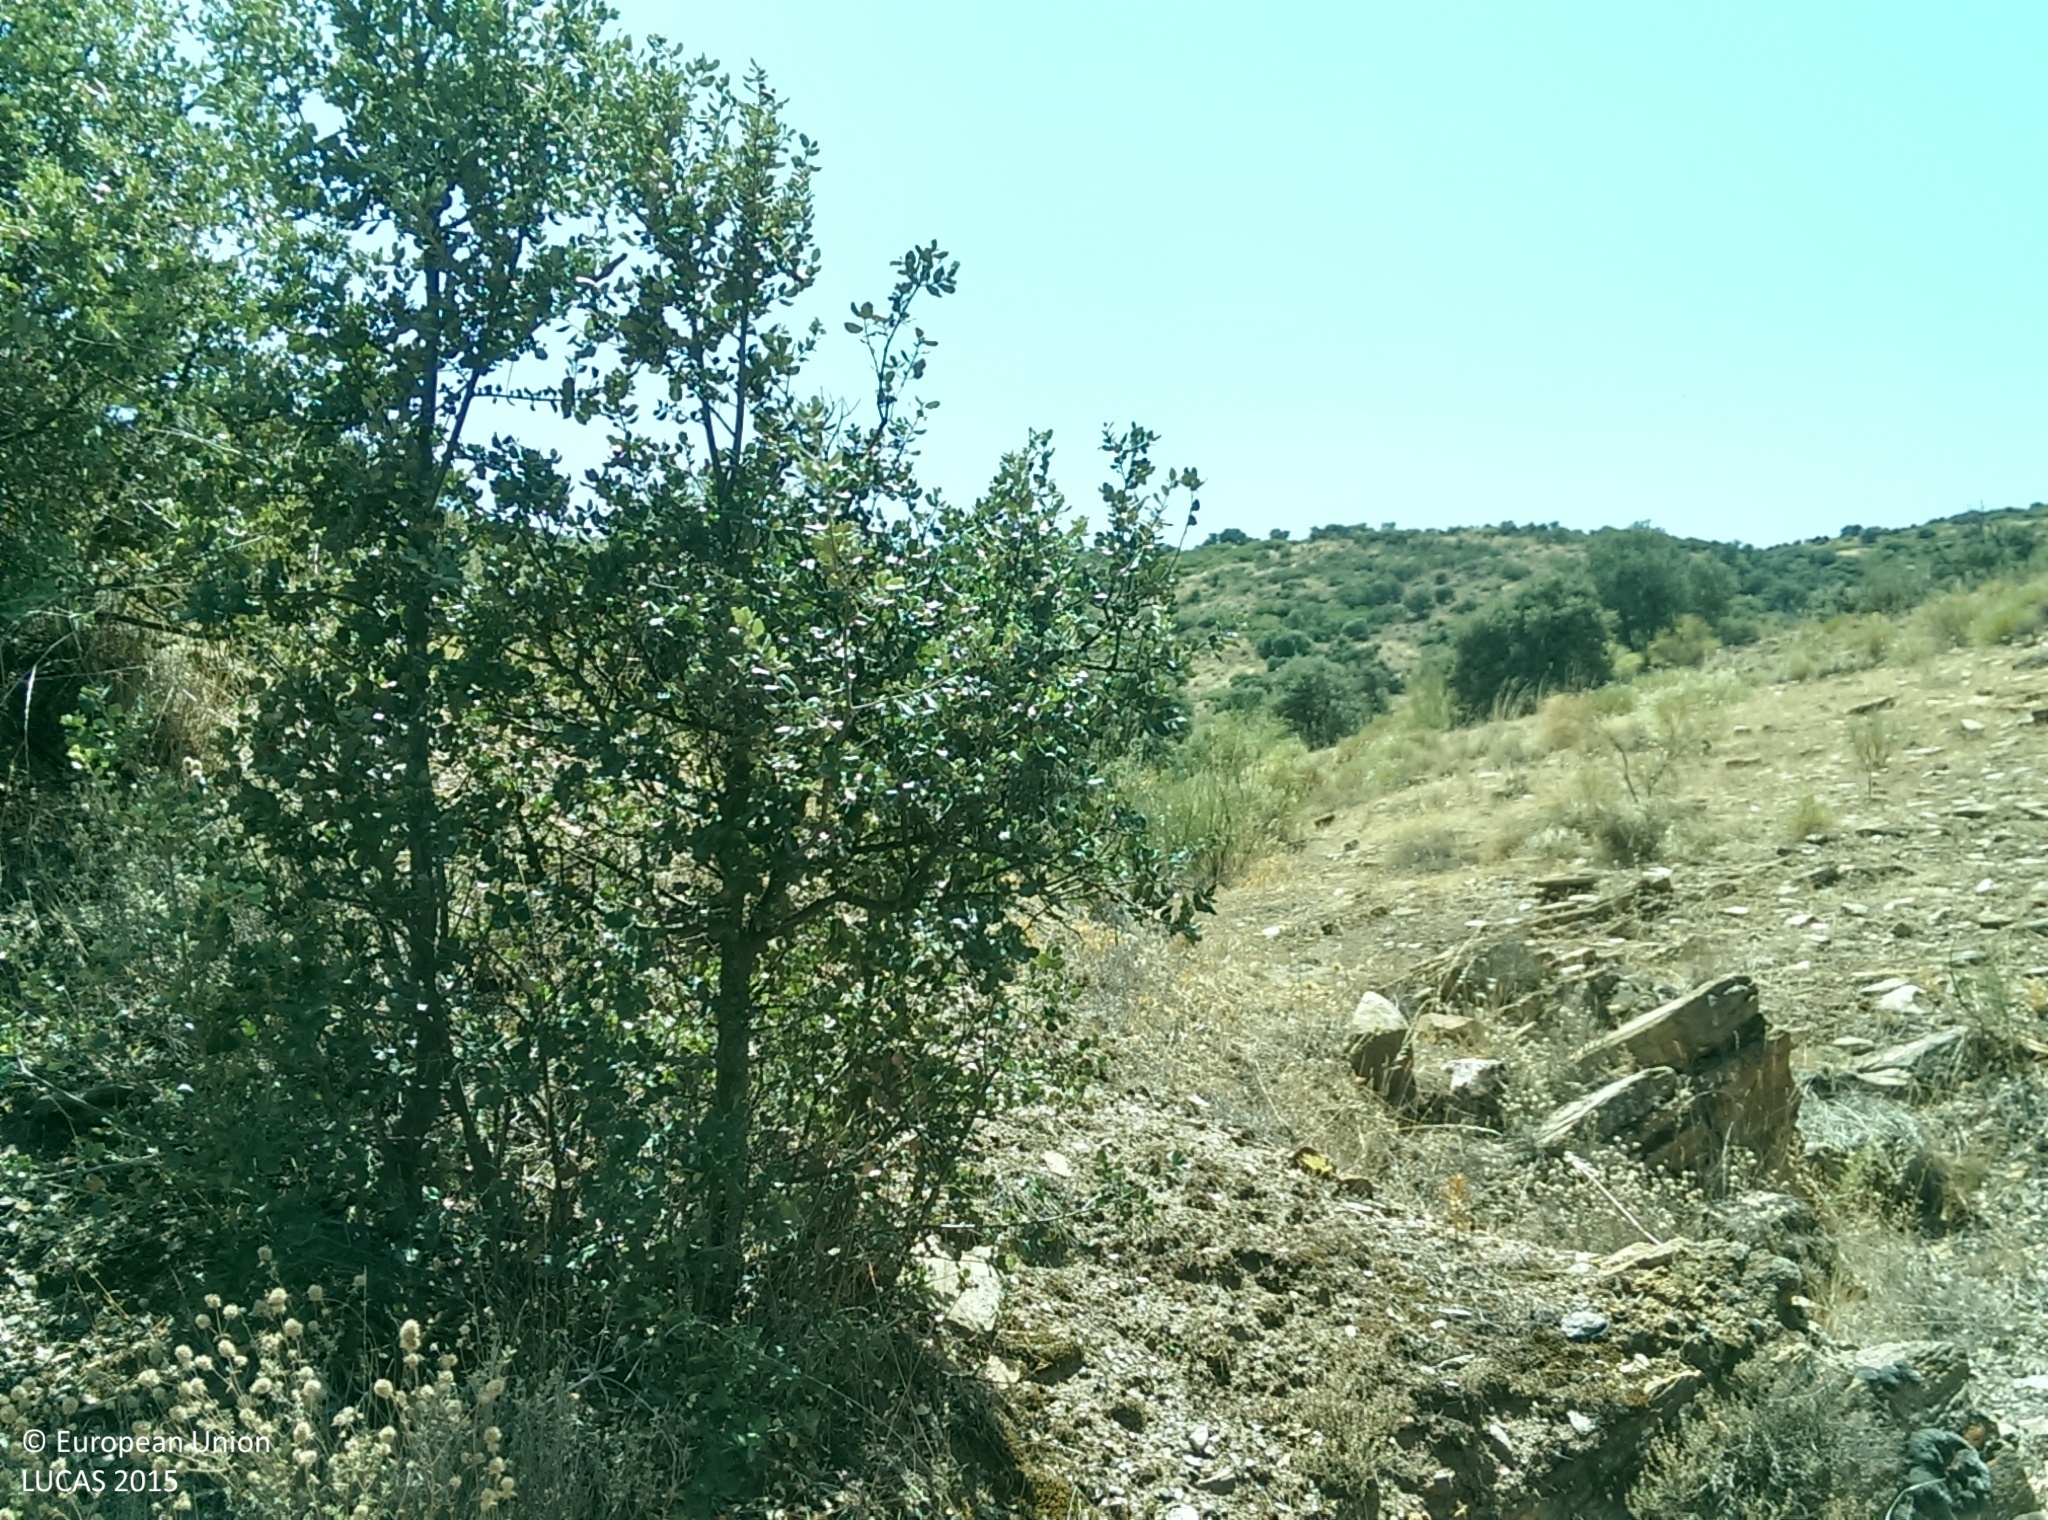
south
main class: Woodland
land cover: Broadleaved woodland
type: broadleaved evergreen forest
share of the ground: 25 - 50 %
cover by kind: broadleaved forest trees 45 %, shrubs 25 %, herbaceous plants 20 %, unconsolidated bare surface 10 %
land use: Semi-natural and natural areas not in use
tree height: < 5 m
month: July
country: ES
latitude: 37.2436
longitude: -3.2102
